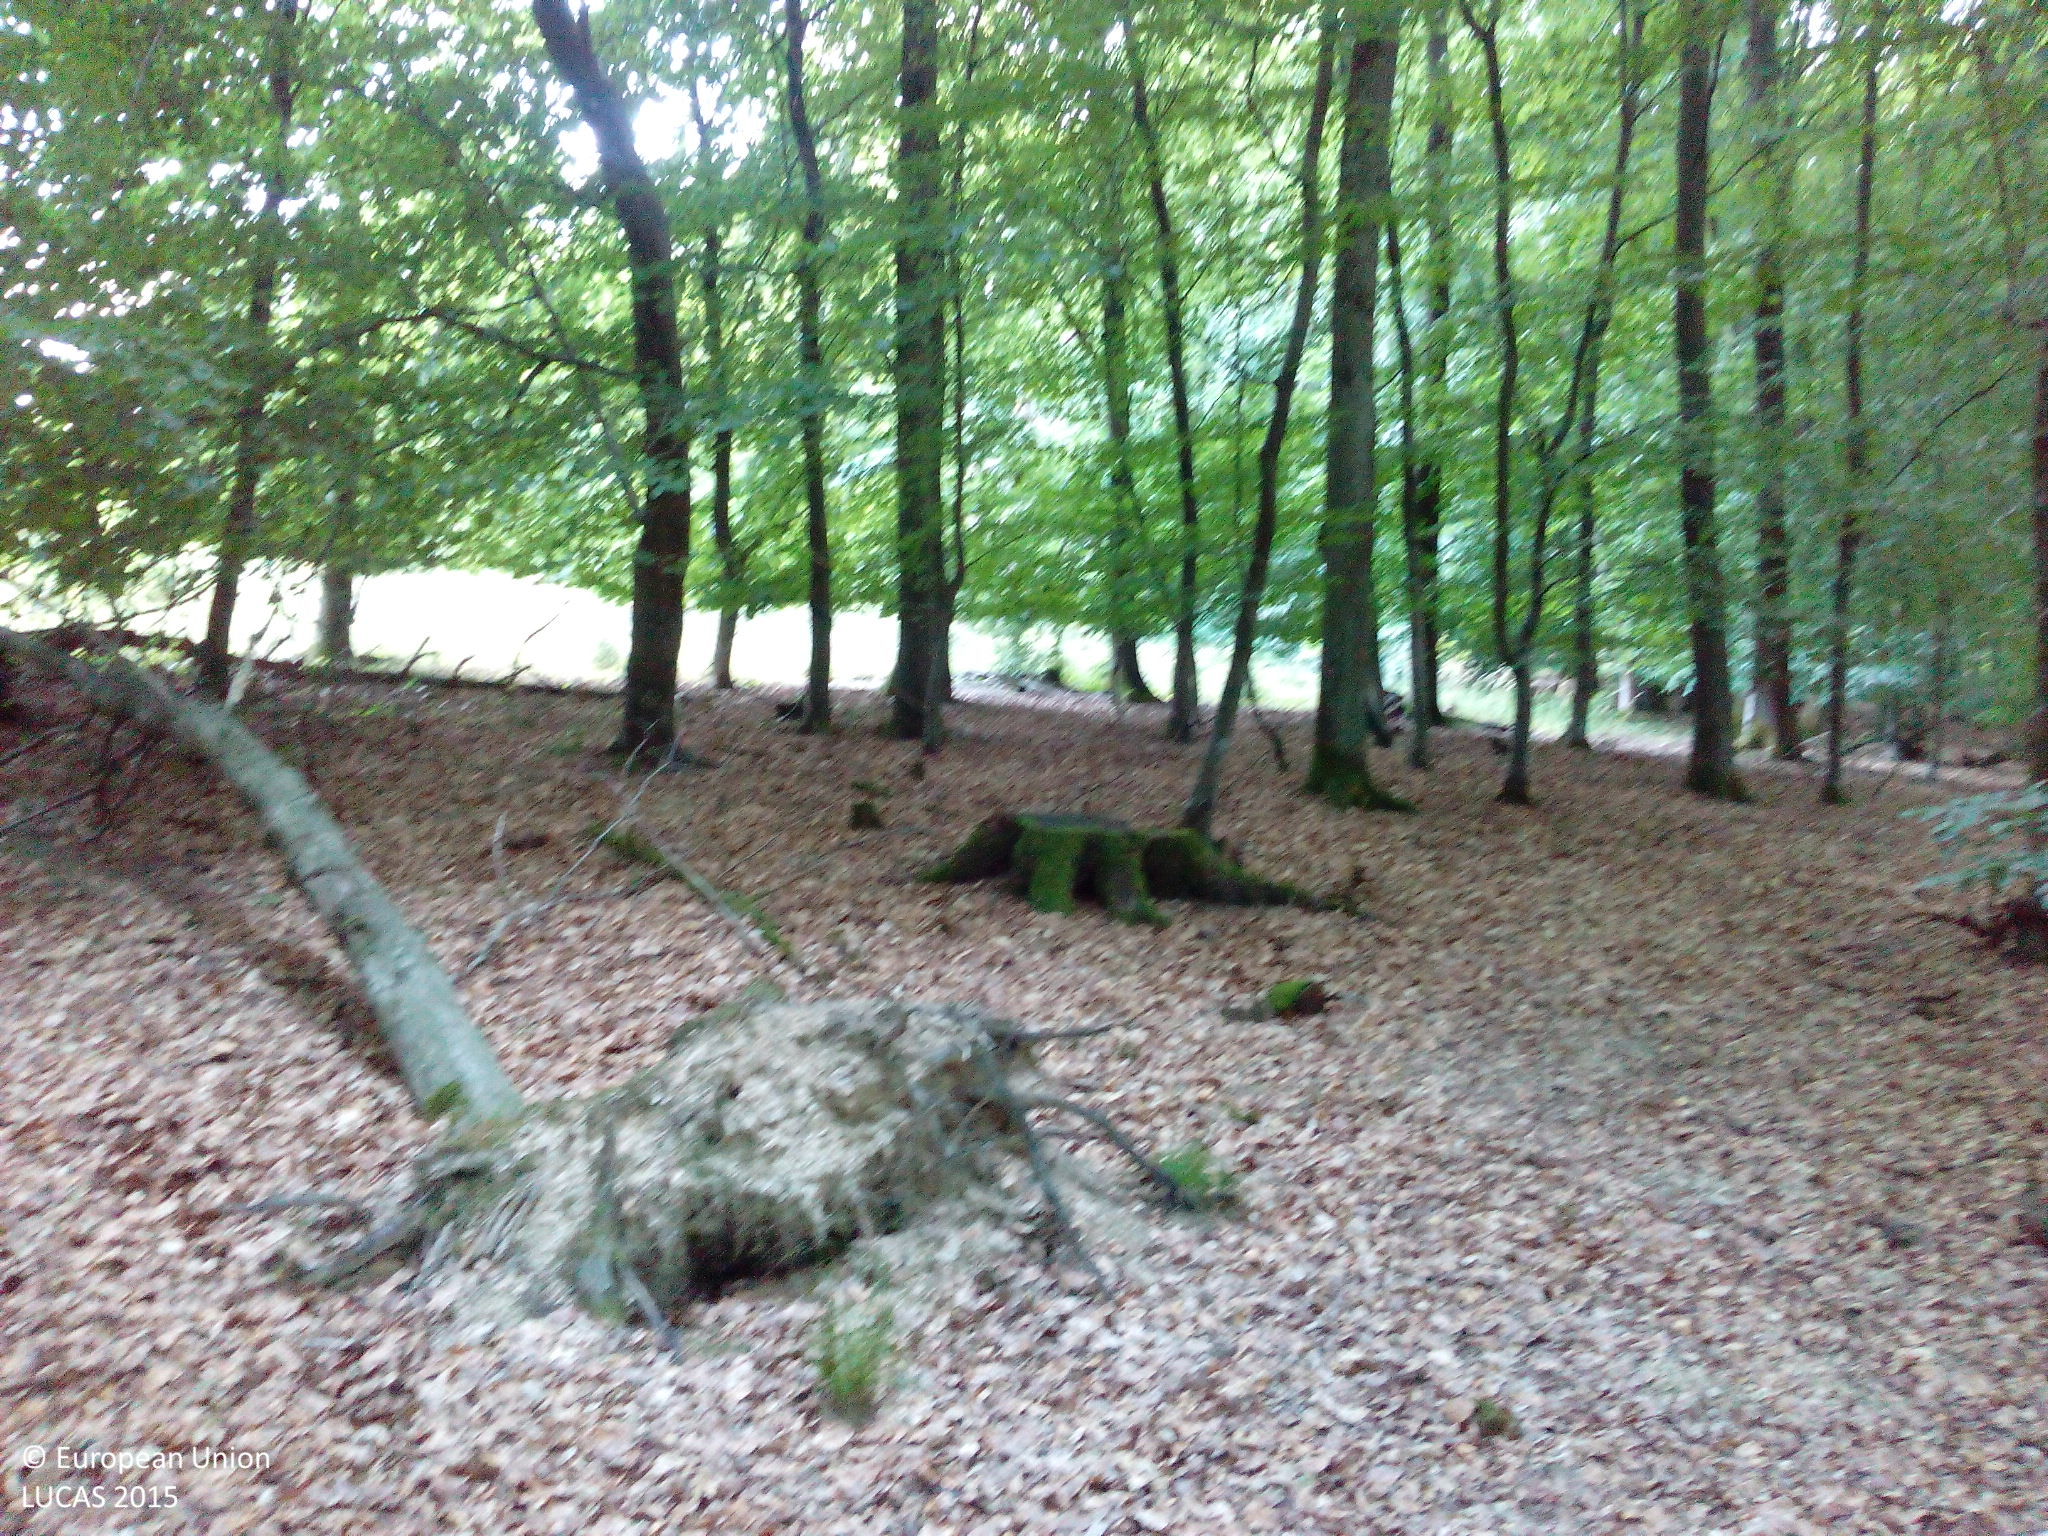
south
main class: Woodland
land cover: Broadleaved woodland
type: beech forest
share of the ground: > 75 %
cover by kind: broadleaved forest trees 90 %, unconsolidated bare surface 10 %
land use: Forestry
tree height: > 5 m
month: August
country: DE
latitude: 50.1034
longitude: 7.5256
